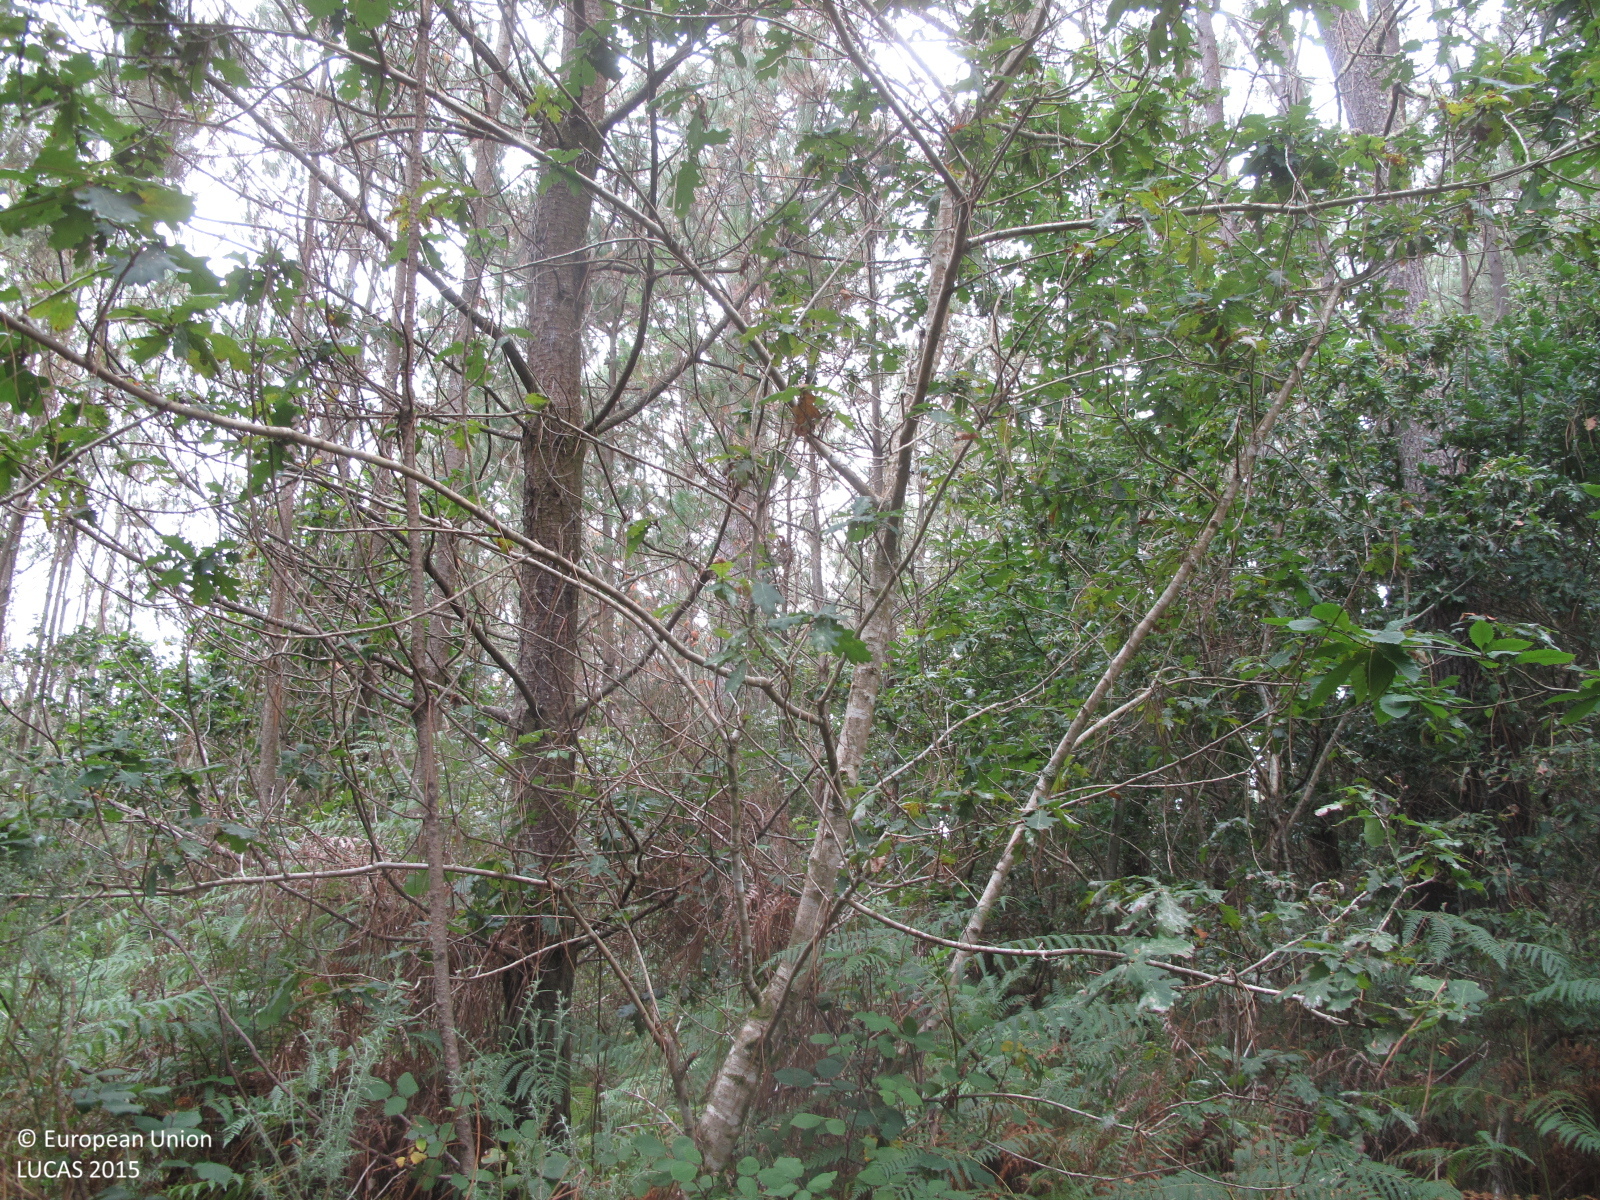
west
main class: Woodland
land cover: Pine dominated mixed woodland
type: hemiboreal forest and nemoral coniferous forest and mixed broadleaved-coniferous forest
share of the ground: 50 - 75 %
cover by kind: coniferous forest trees 40 %, shrubs 30 %, broadleaved forest trees 20 %, herbaceous plants 10 %
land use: Forestry
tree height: > 5 m
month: July
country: ES
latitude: 42.9941
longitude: -9.2262
